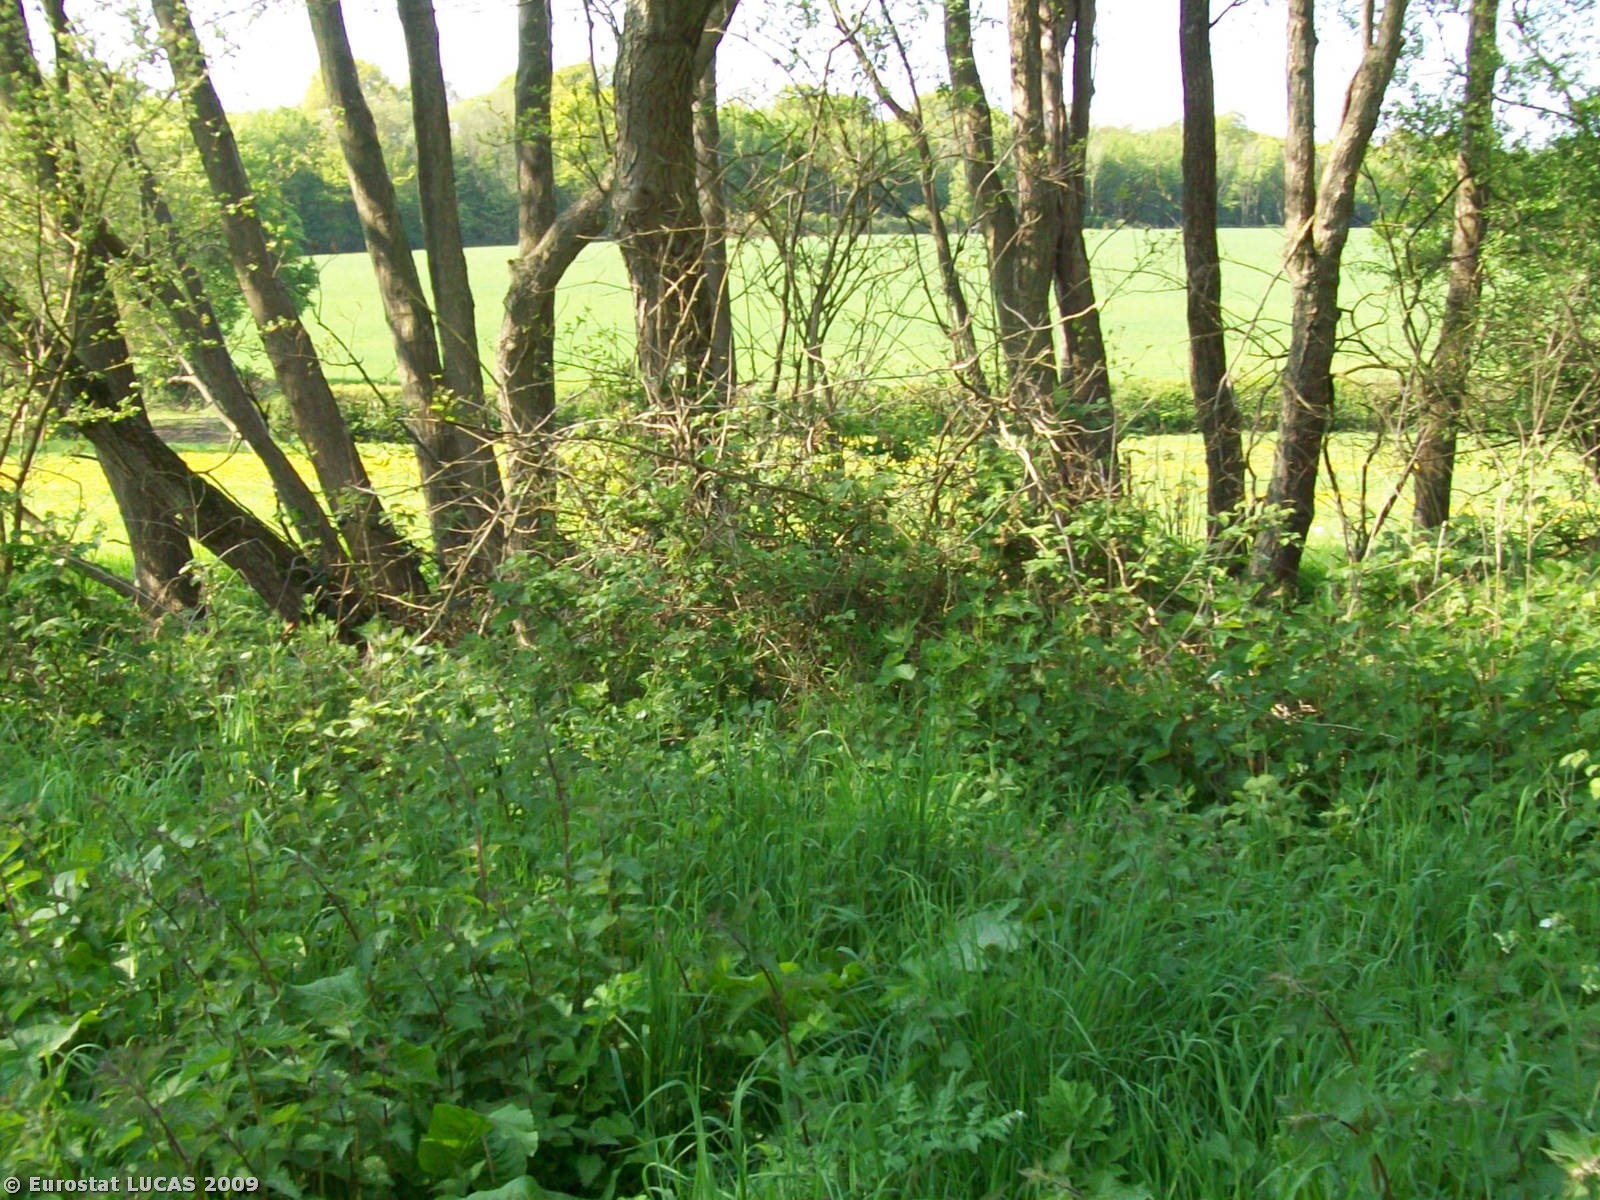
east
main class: Grassland
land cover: Grassland without tree/shrub cover
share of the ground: > 75 %
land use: Agriculture (excluding fallow land and kitchen gardens)
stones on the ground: < 10 %
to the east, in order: Grassland without tree/shrub cover
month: May
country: GB
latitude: 51.0235
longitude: 0.3473
